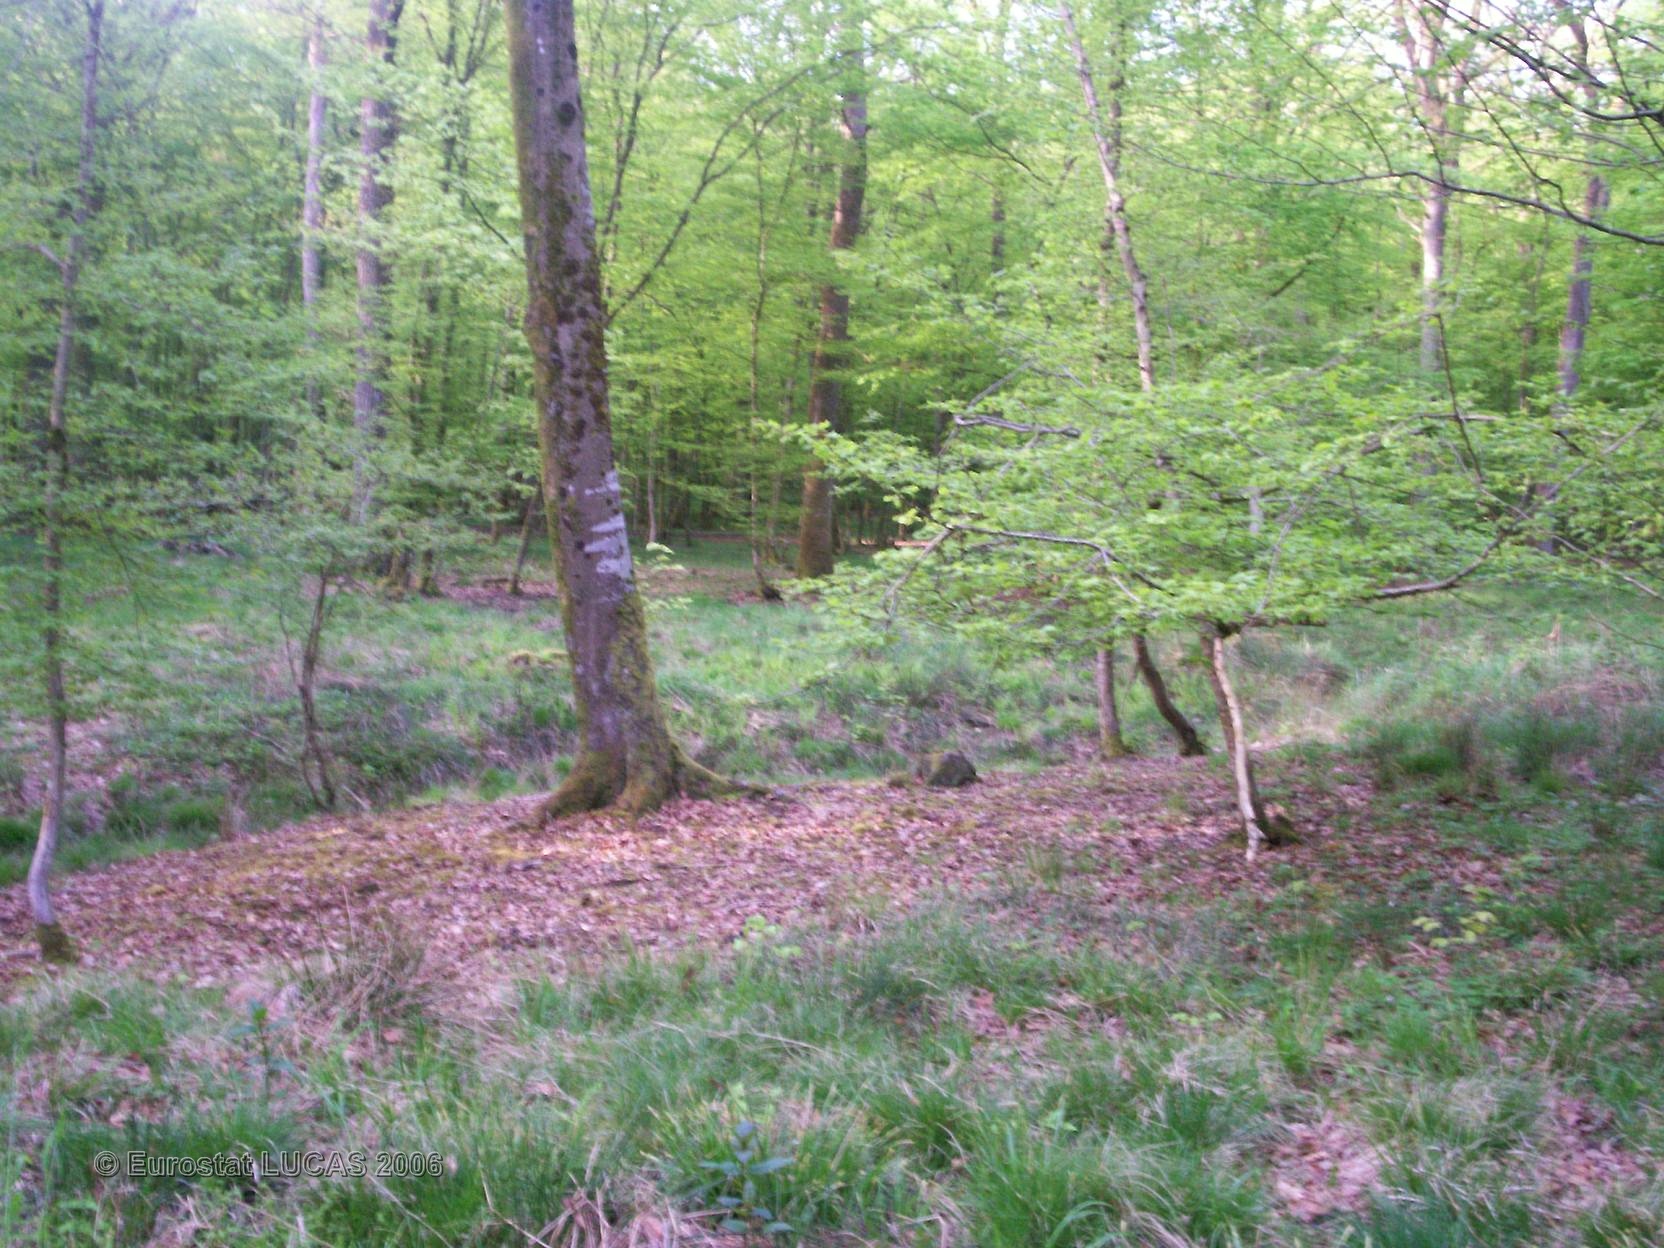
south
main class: Woodland
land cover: Broadleaved forest
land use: Forestry
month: May
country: FR
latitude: 48.9744
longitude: 6.9812
